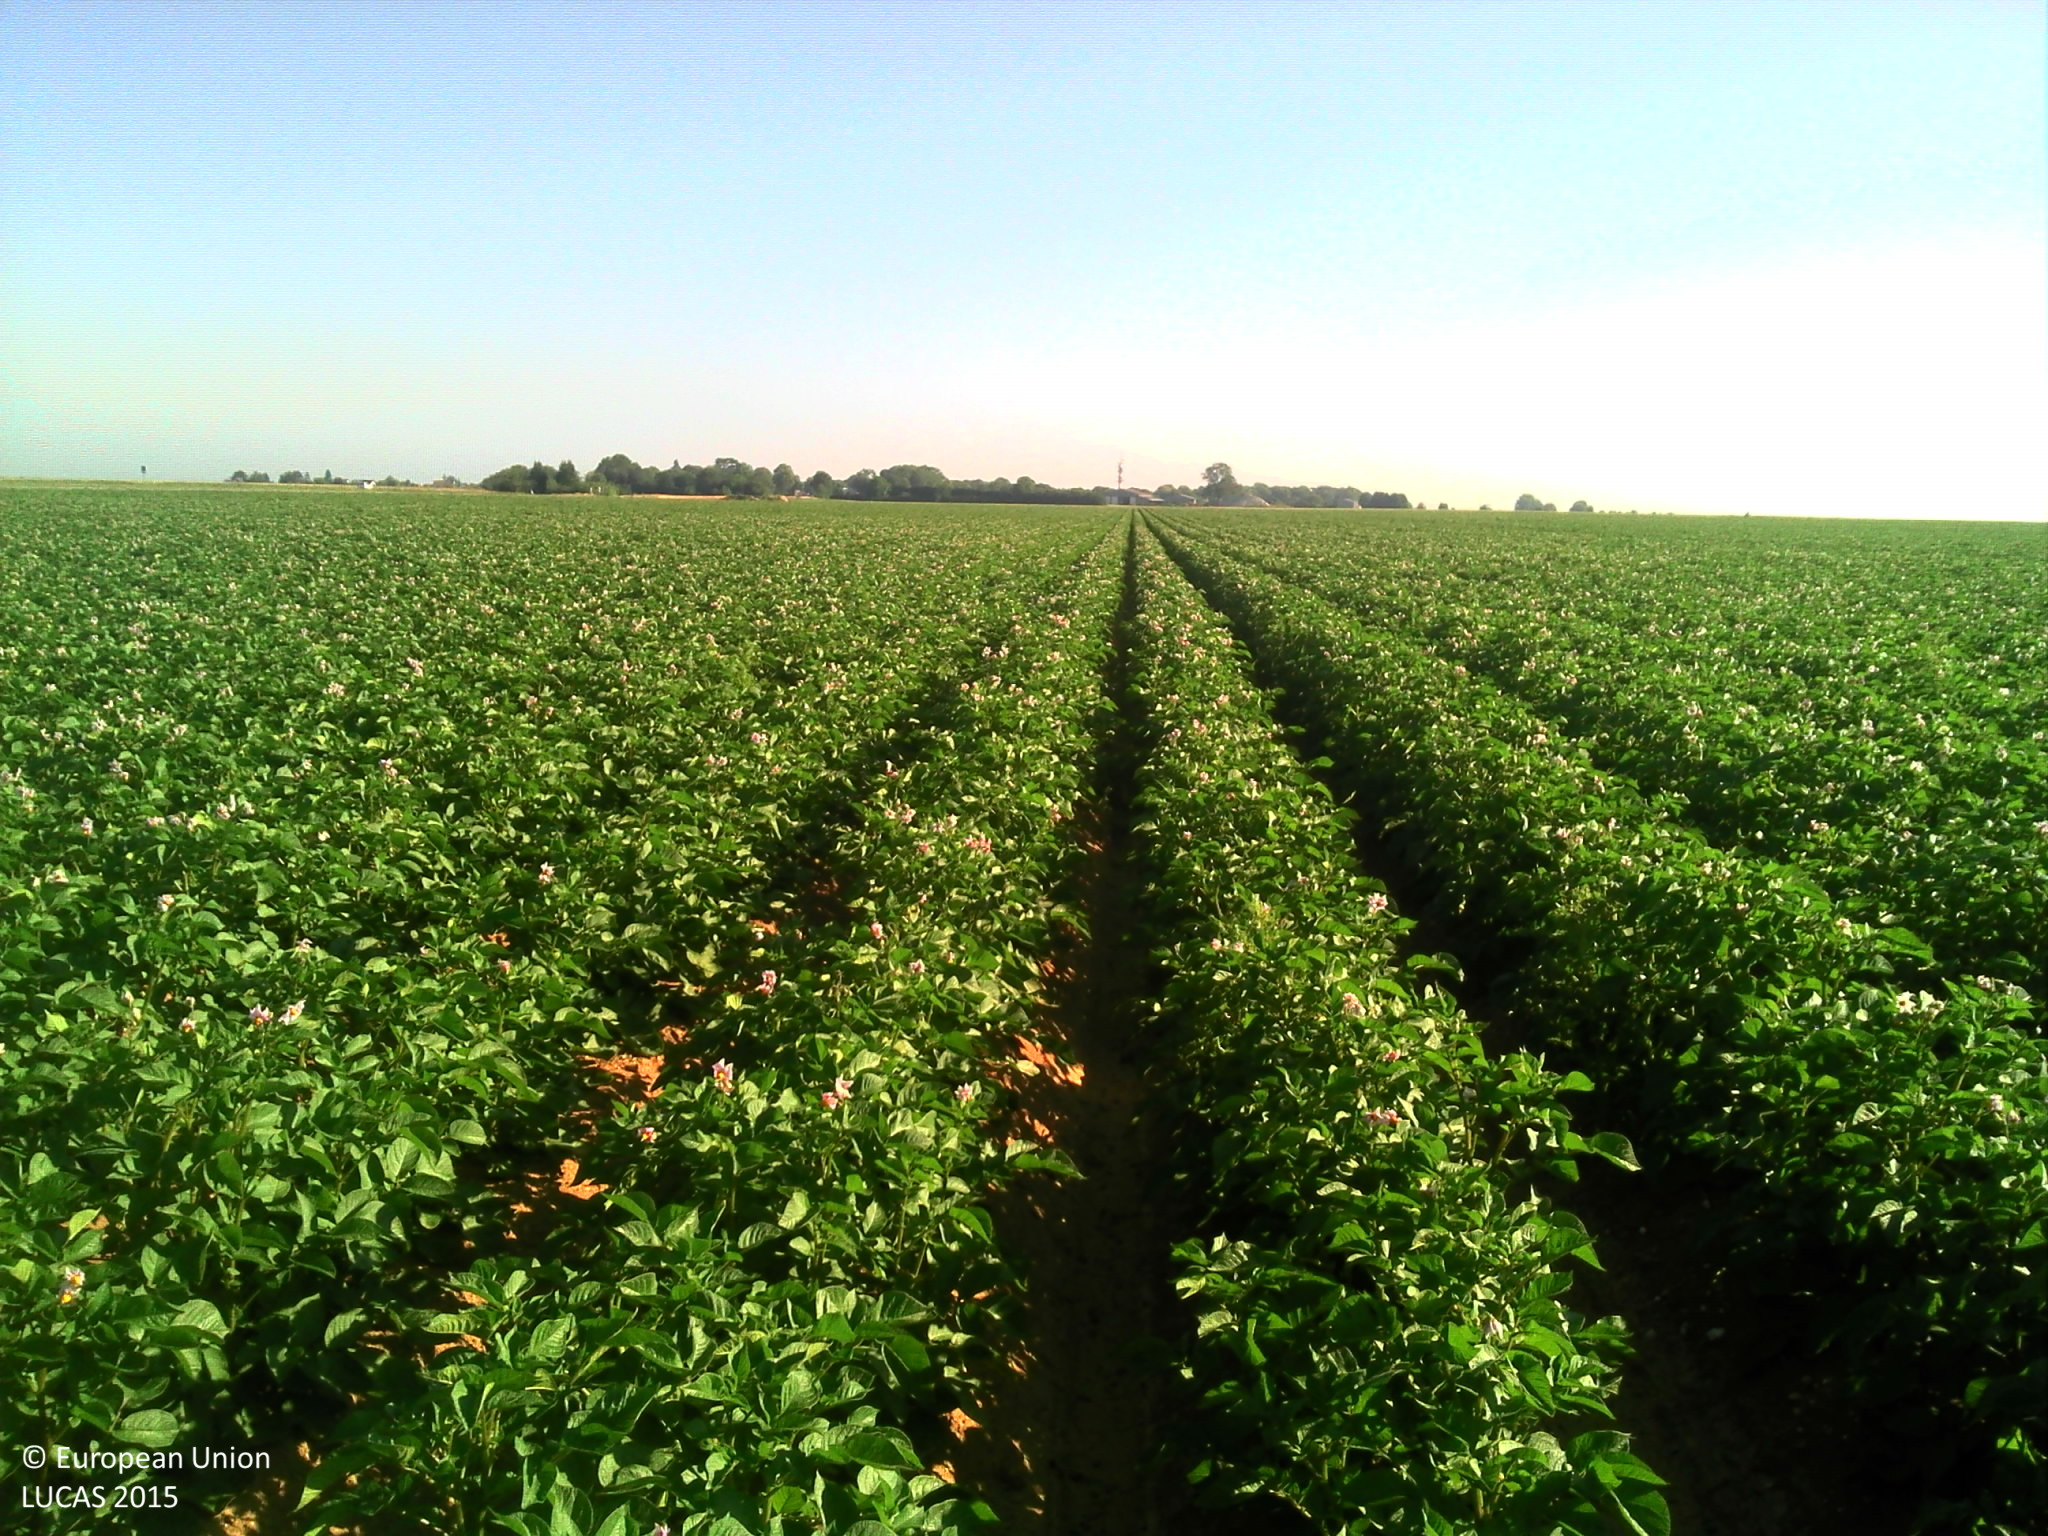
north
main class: Cropland
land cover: Potatoes
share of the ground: > 75 %
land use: Agriculture (excluding fallow land and kitchen gardens)
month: June
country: FR
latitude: 49.8313
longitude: 2.2706
